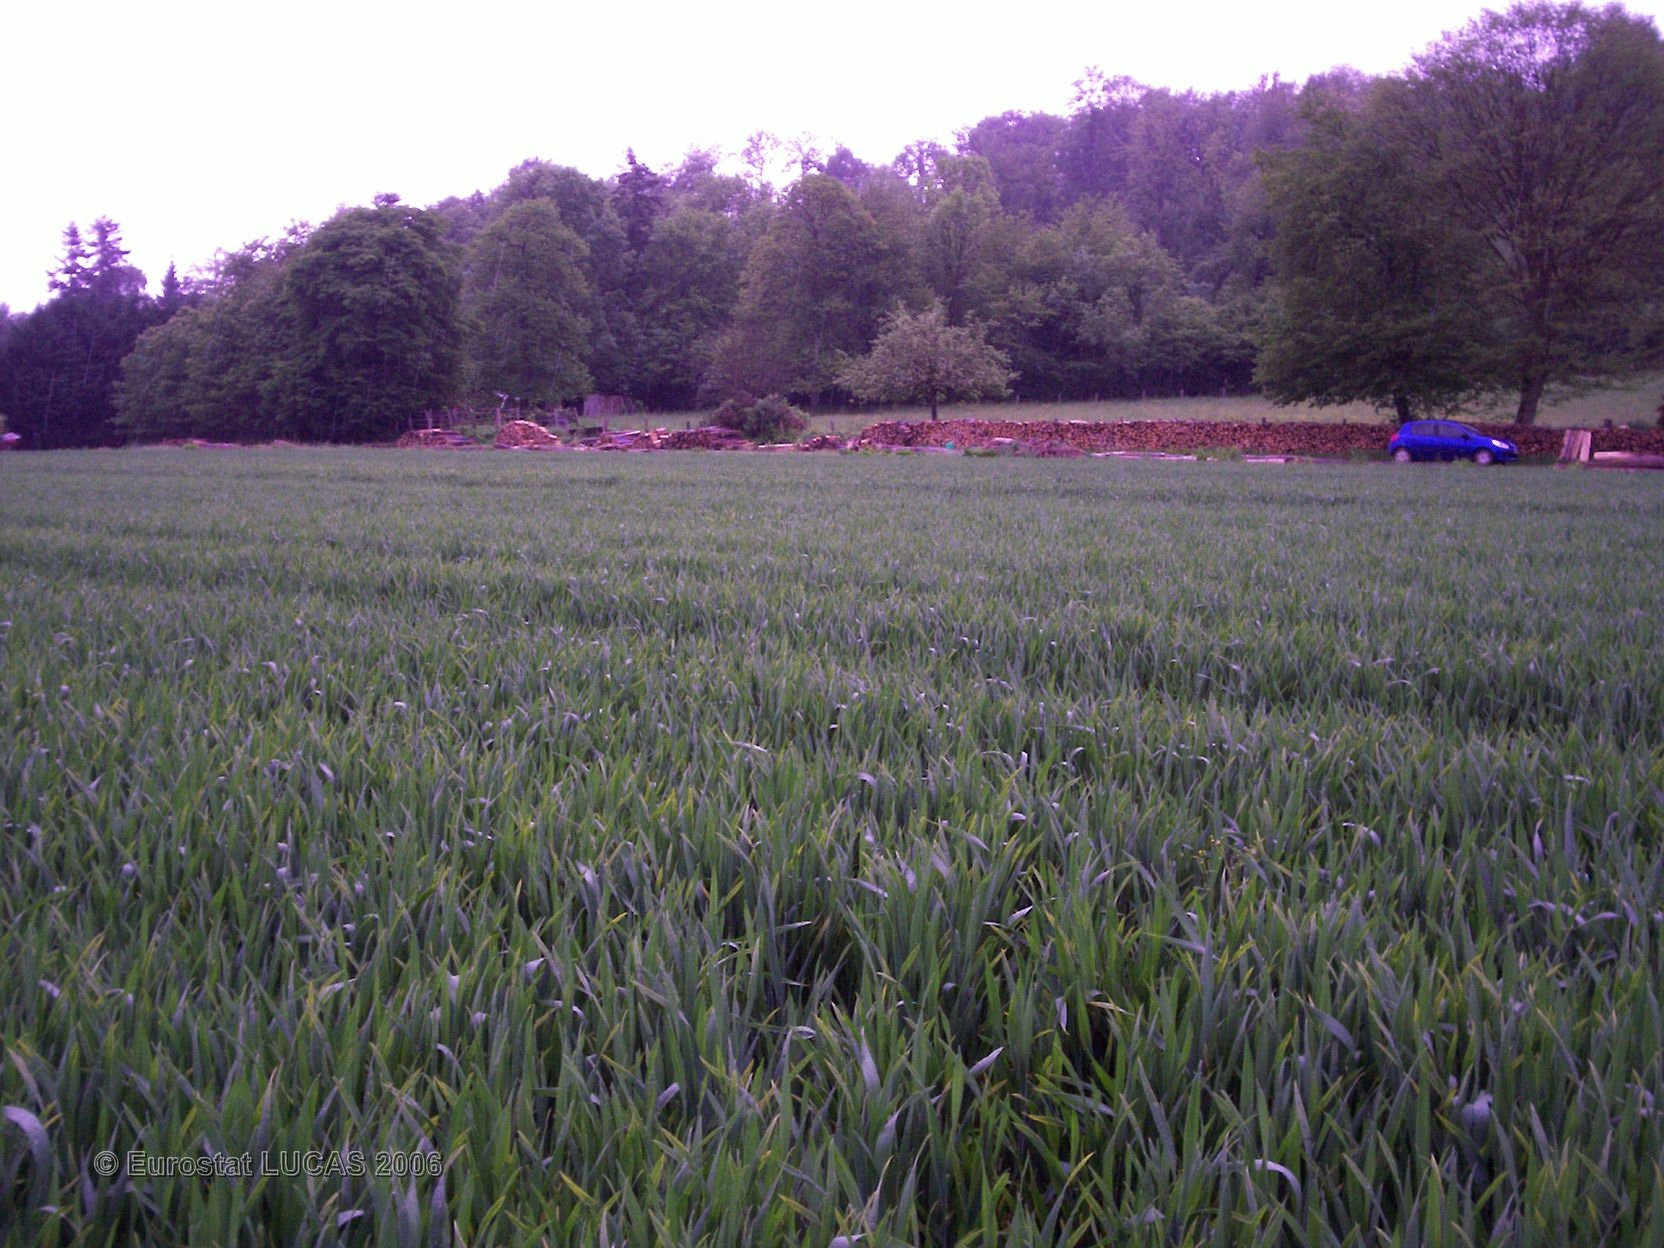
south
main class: Cropland
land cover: Common wheat
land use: Agriculture (excluding fallow land and kitchen gardens)
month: May
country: FR
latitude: 49.3666
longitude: 0.4577
